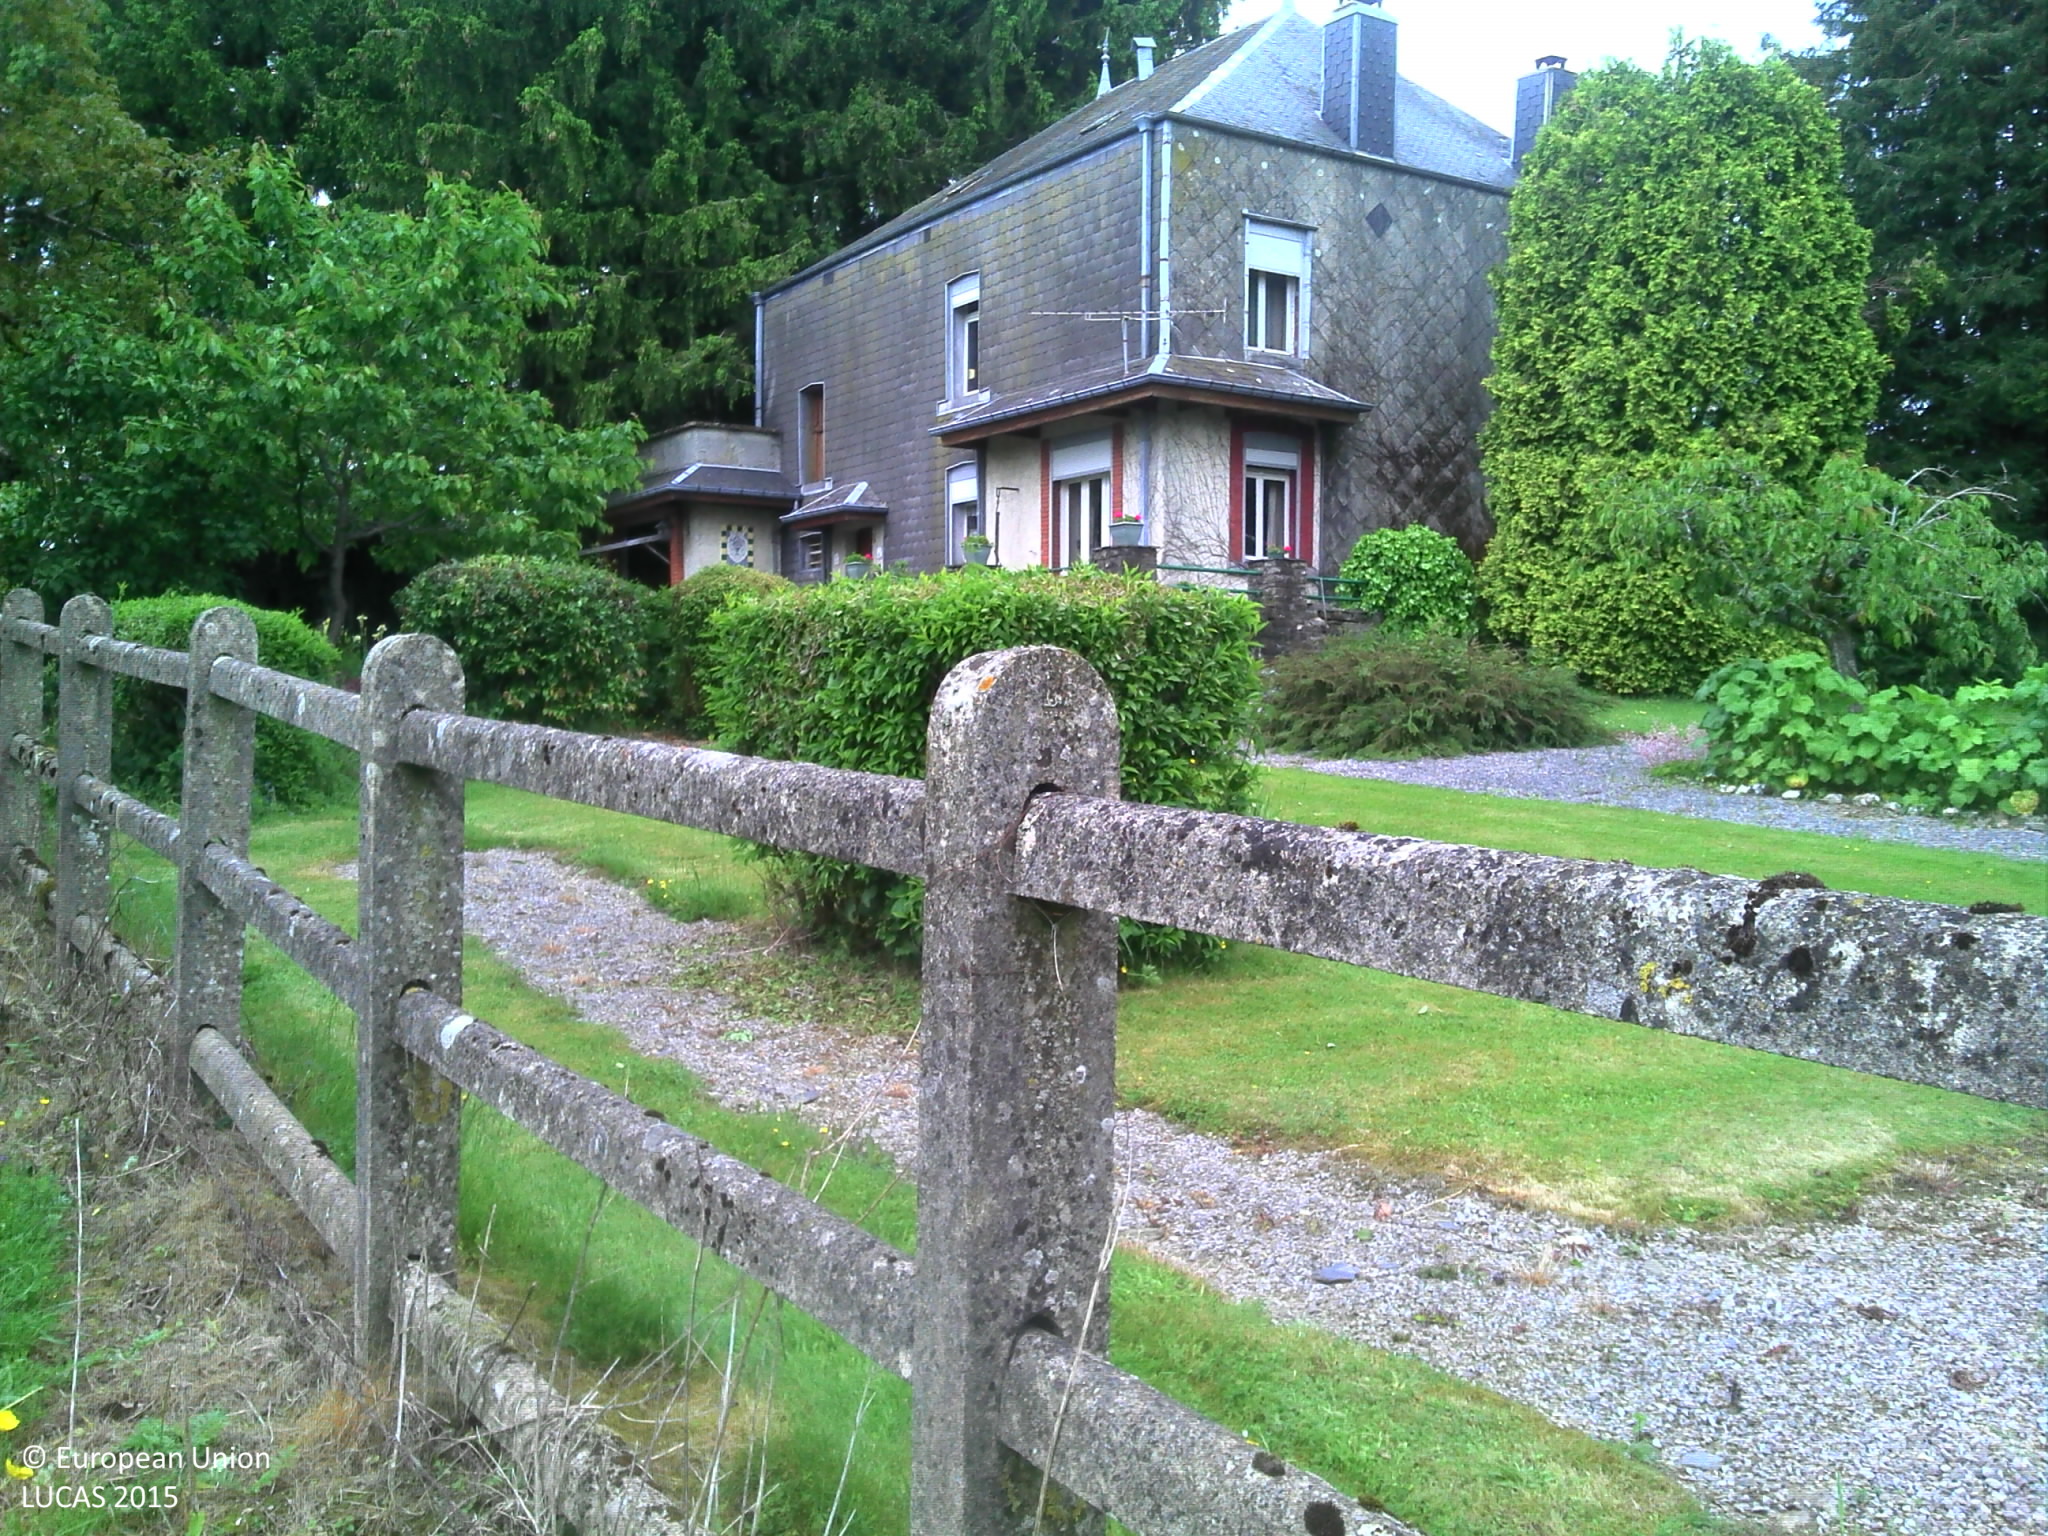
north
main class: Grassland
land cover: Grassland with sparse tree/shrub cover
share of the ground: > 75 %
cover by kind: herbaceous plants 90 %, broadleaved forest trees 5 %, unconsolidated bare surface 5 %
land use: Residential
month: June
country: BE
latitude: 49.8177
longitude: 4.8964
